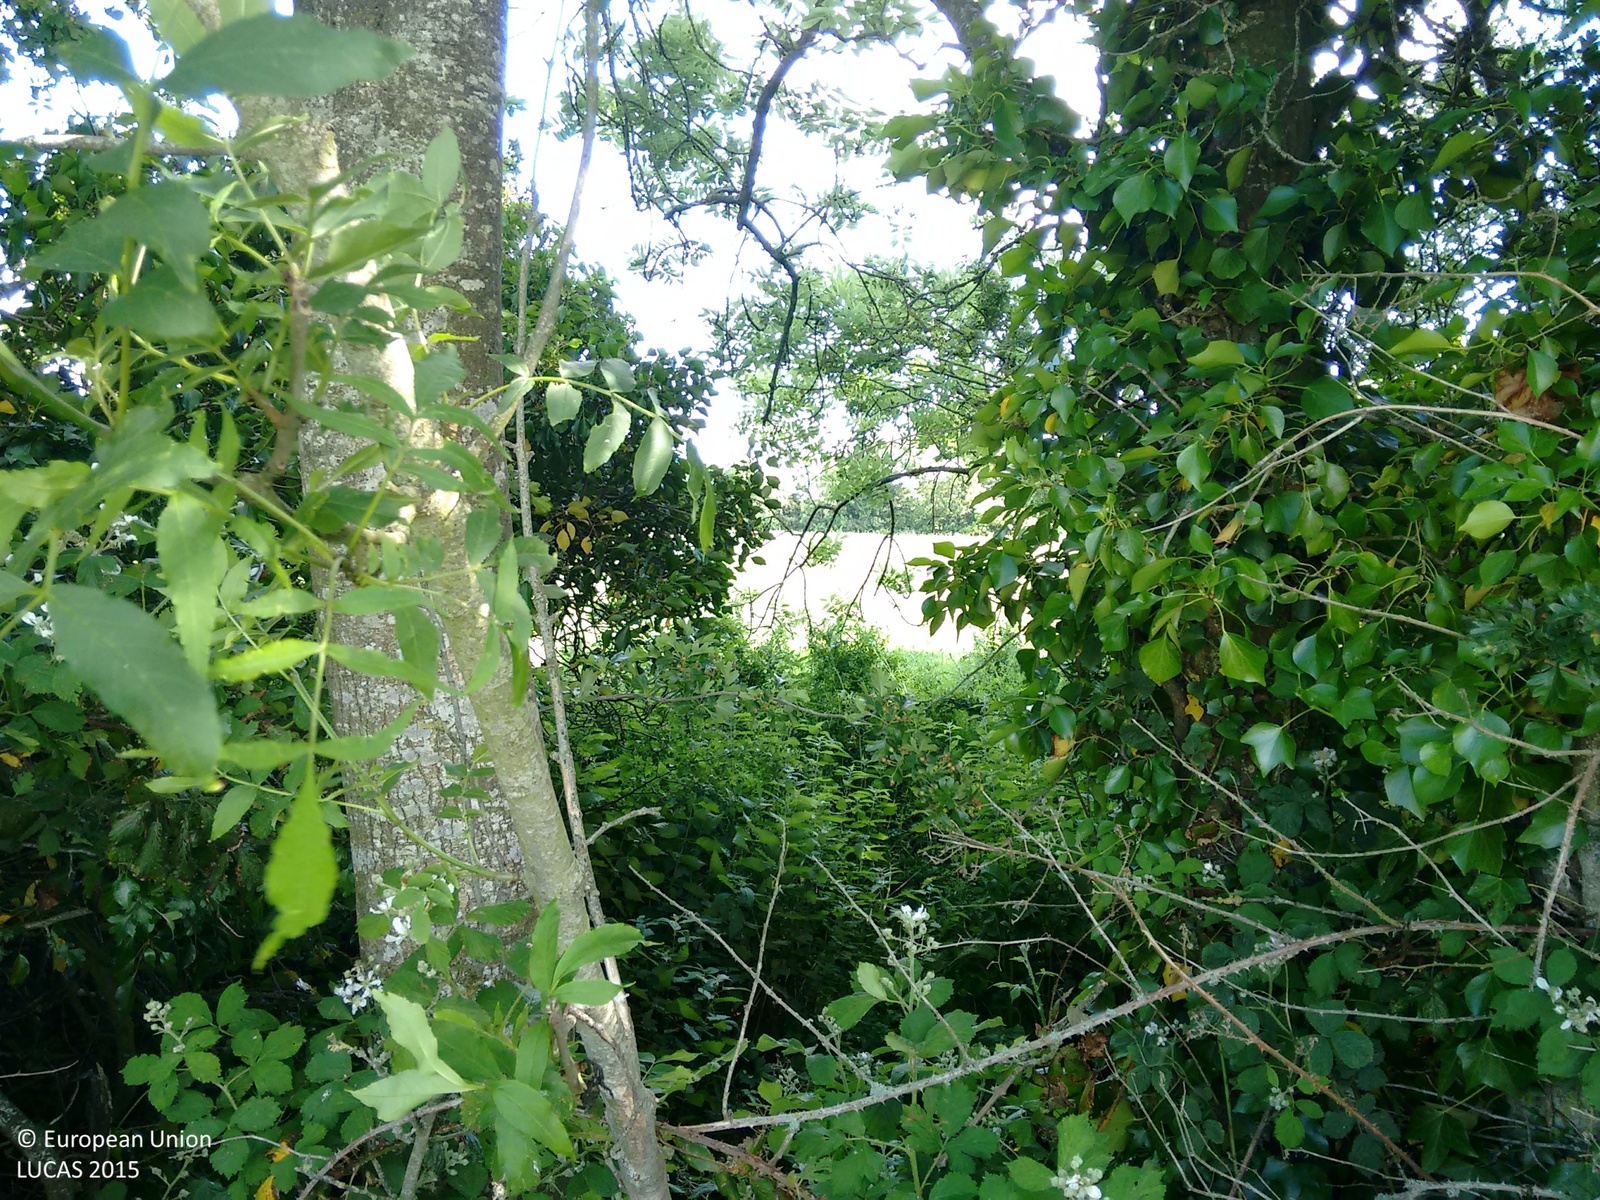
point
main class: Grassland
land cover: Grassland without tree/shrub cover
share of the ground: > 75 %
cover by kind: herbaceous plants 100 %
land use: Agriculture (excluding fallow land and kitchen gardens)
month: June
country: IE
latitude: 53.6639
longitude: -6.7041
